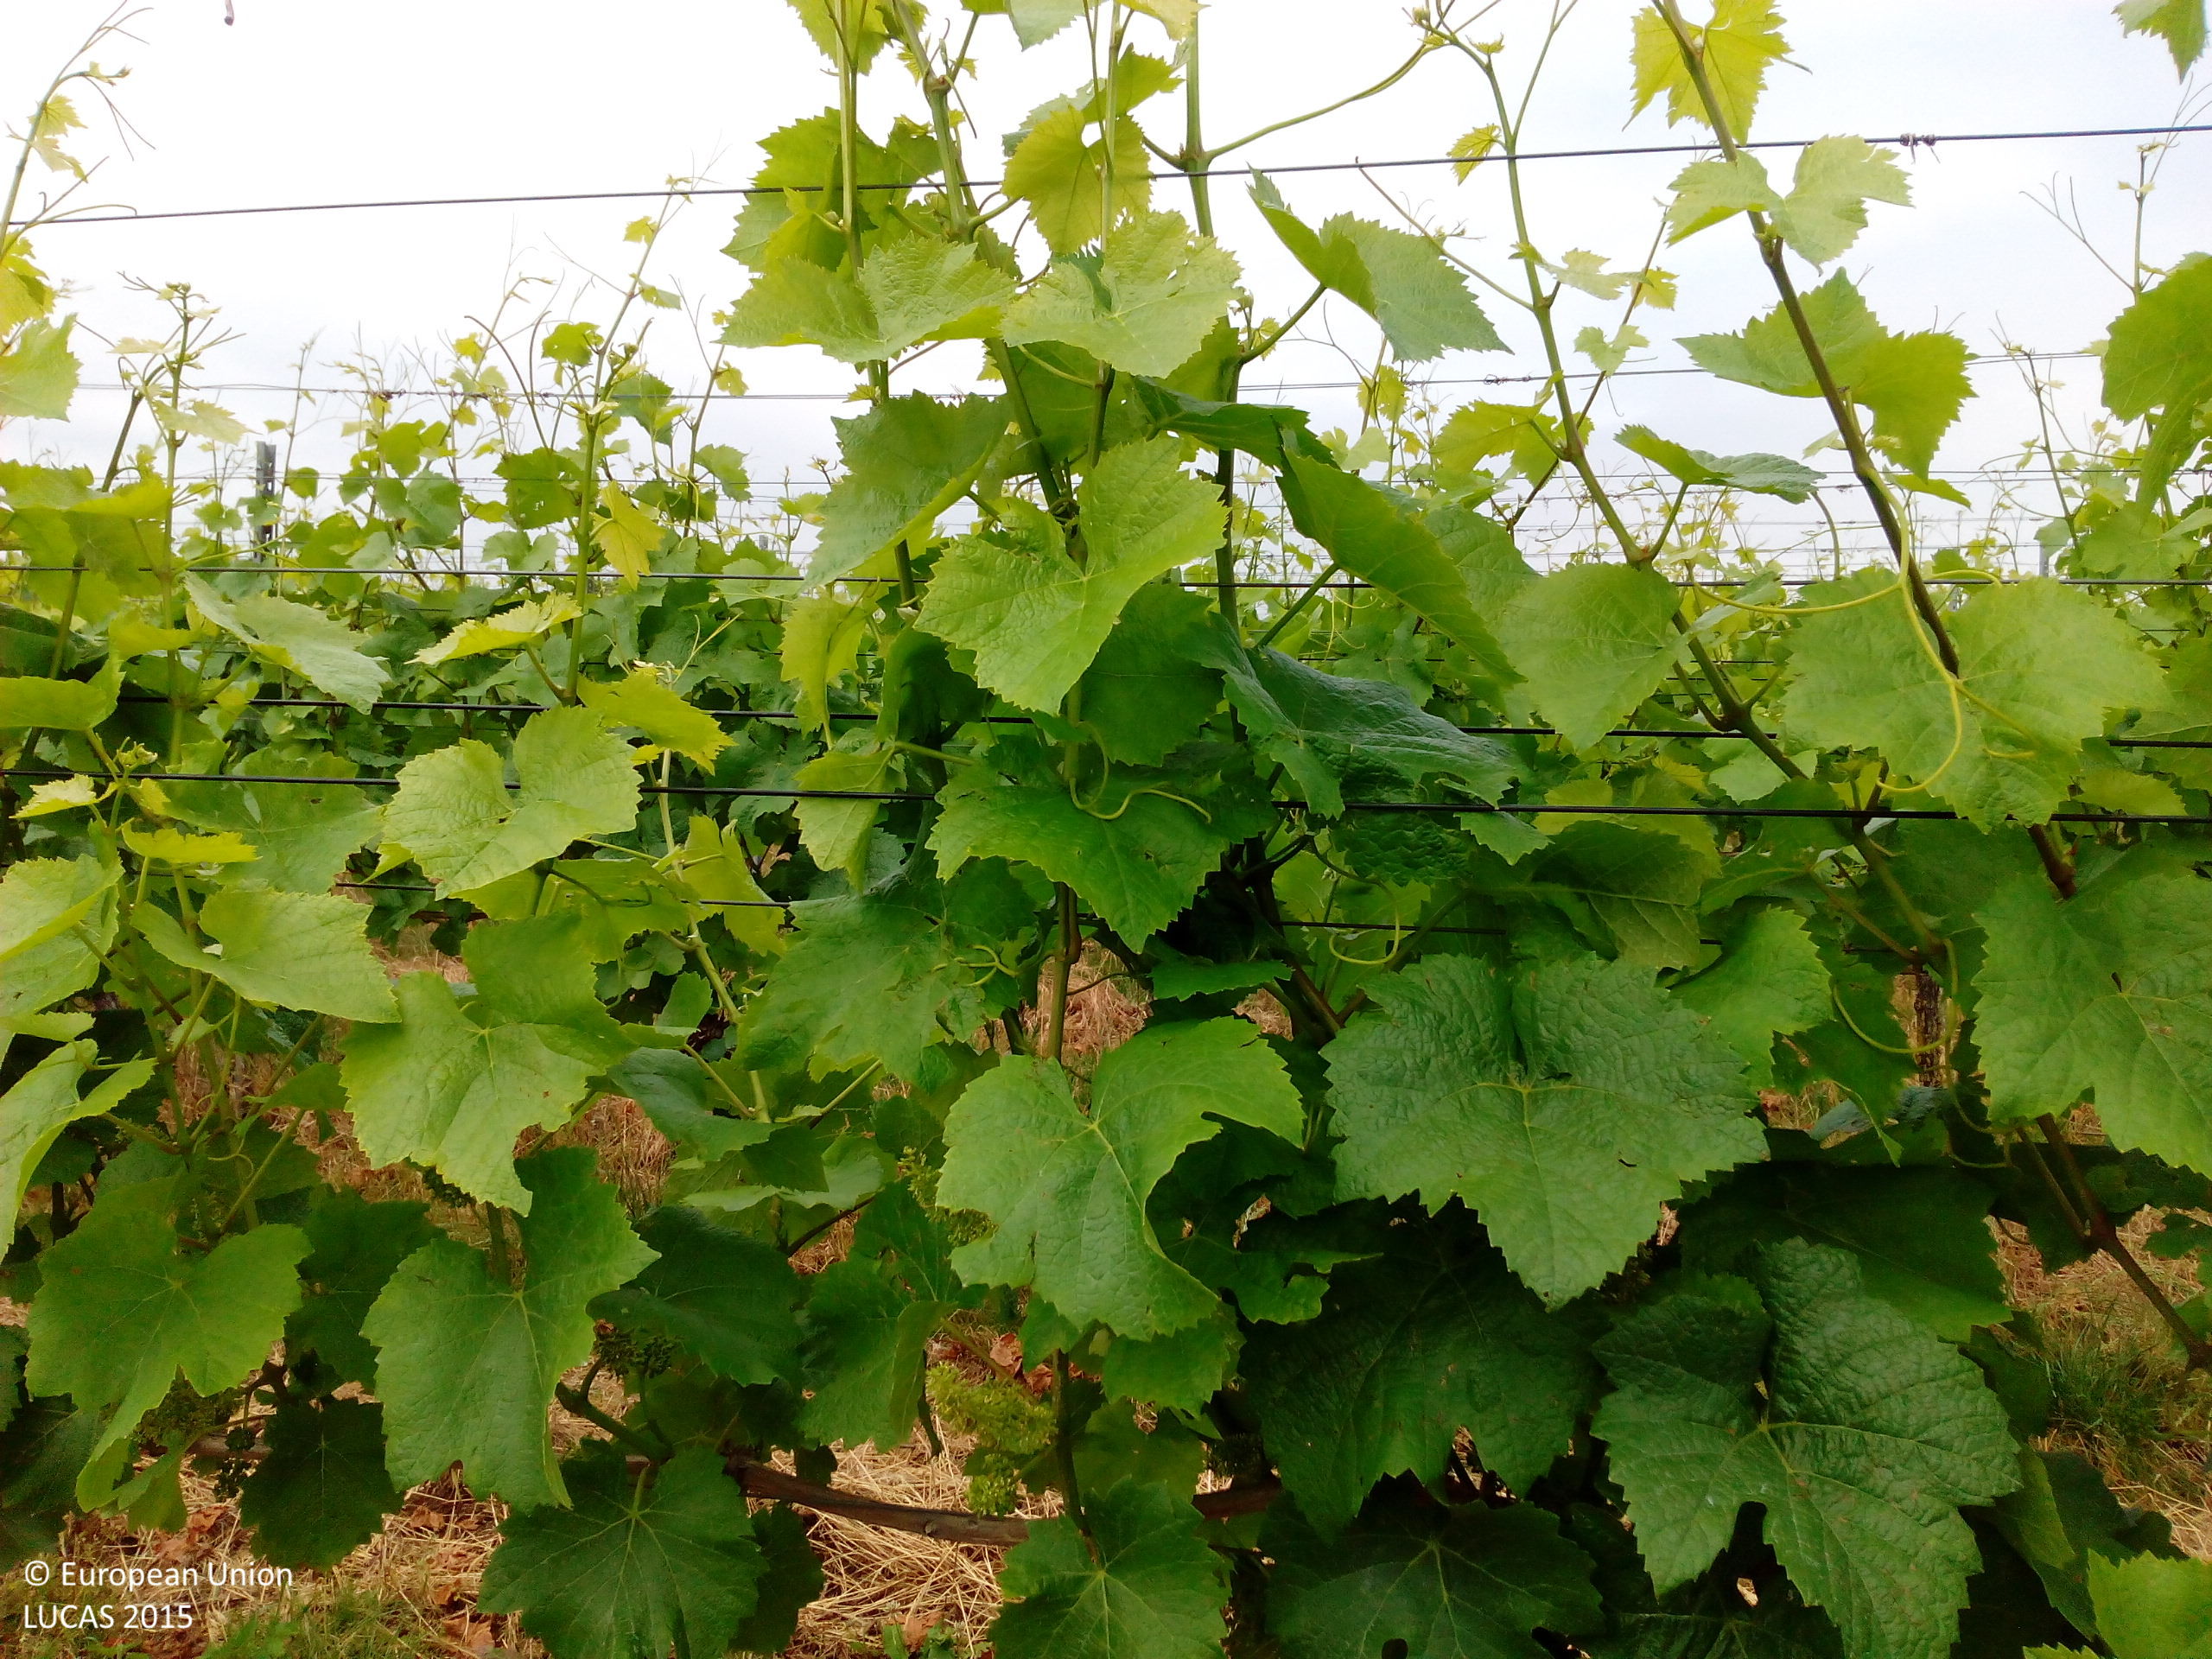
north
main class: Cropland
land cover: Vineyards
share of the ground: 25 - 50 %
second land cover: Grassland without tree/shrub cover
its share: 50 - 75 %
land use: Agriculture (excluding fallow land and kitchen gardens)
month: June
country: DE
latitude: 48.1074
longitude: 7.5971
